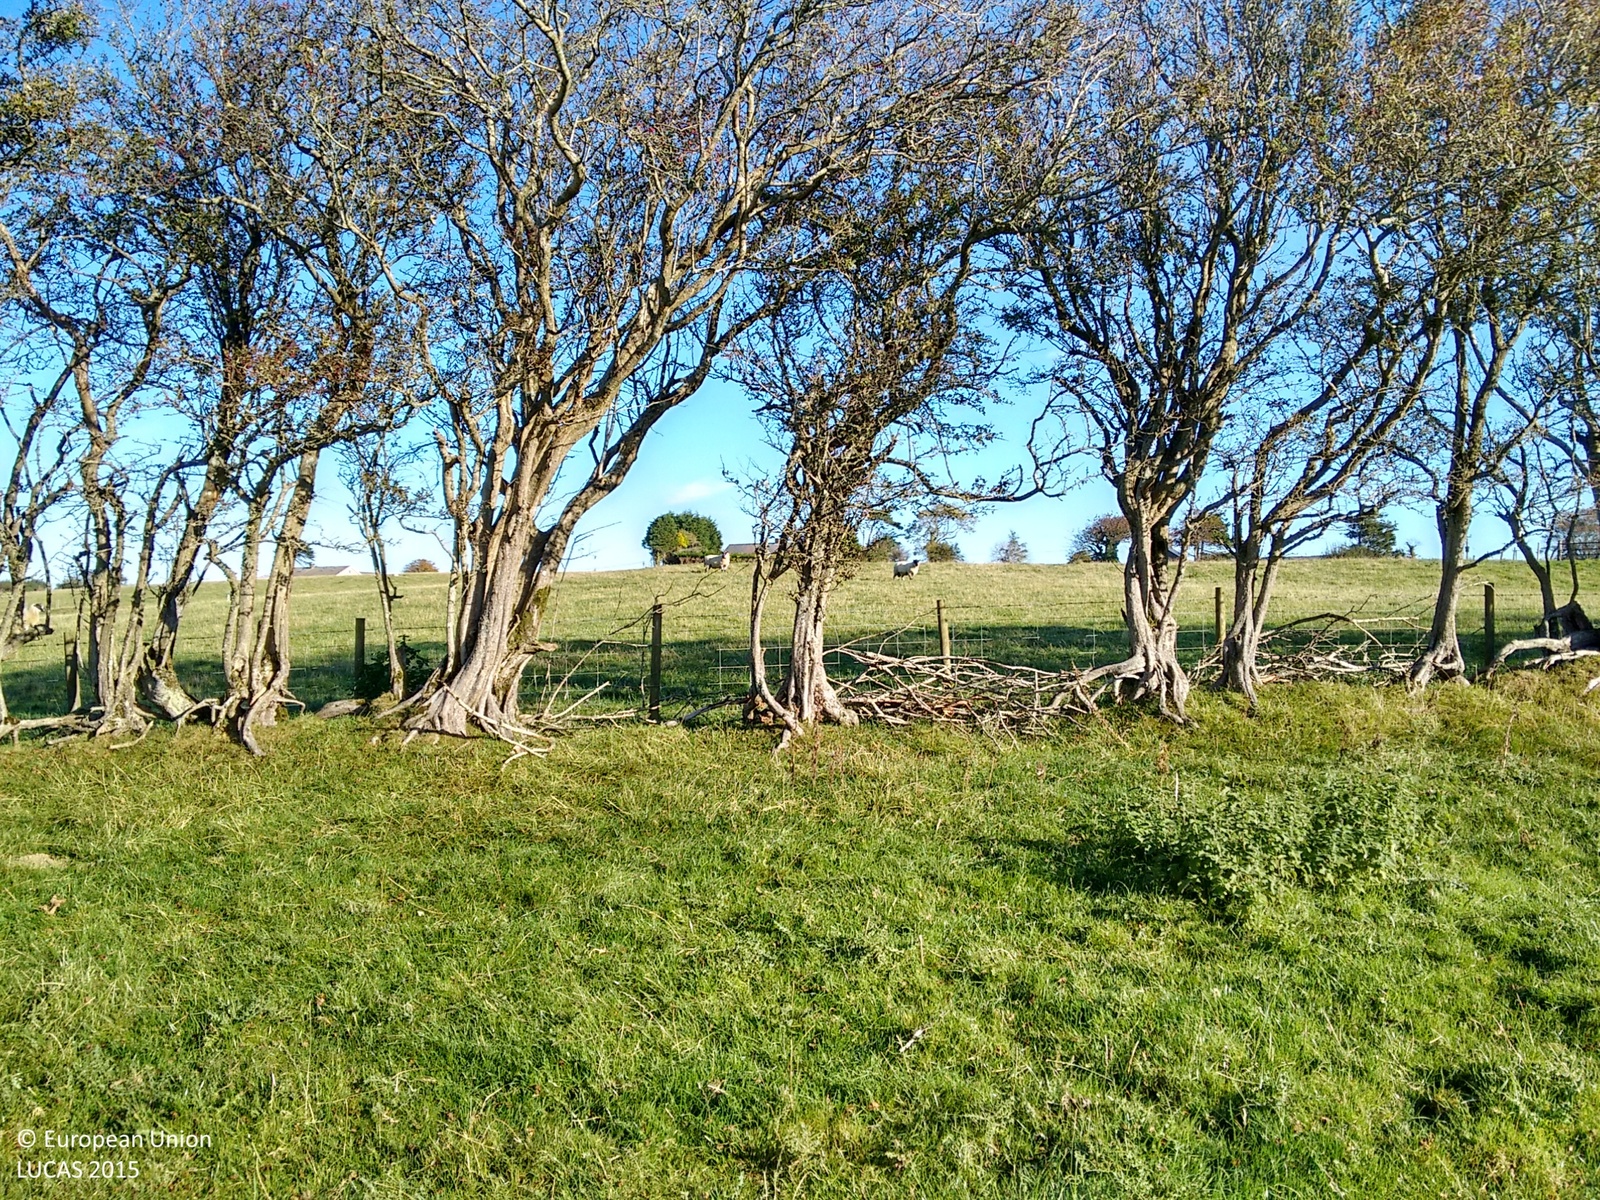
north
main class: Grassland
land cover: Grassland without tree/shrub cover
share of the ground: > 75 %
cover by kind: herbaceous plants 100 %
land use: Agriculture (excluding fallow land and kitchen gardens)
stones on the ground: < 10 %
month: October
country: GB
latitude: 52.3848
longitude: -3.9784
